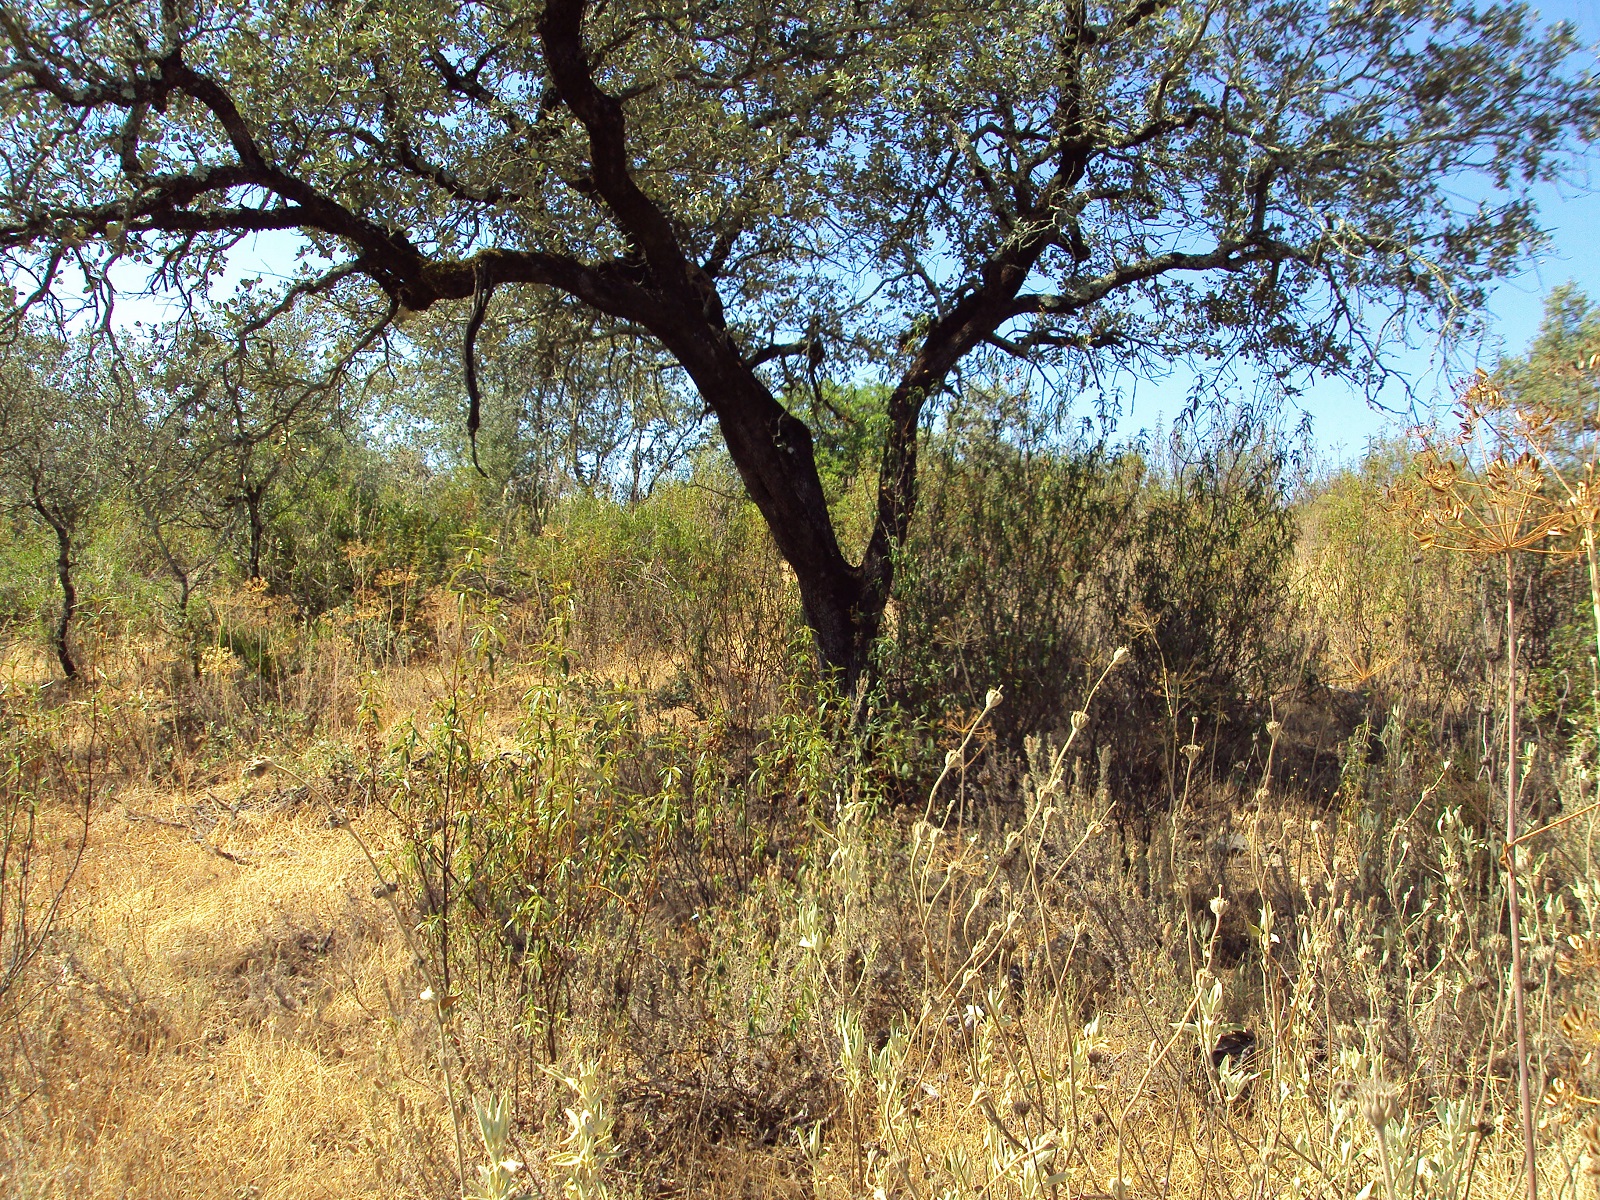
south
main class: Woodland
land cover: Broadleaved woodland
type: broadleaved evergreen forest
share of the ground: 25 - 50 %
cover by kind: shrubs 70 %, broadleaved forest trees 30 %
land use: Semi-natural and natural areas not in use
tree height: < 5 m
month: June
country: ES
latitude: 37.4217
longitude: -6.9113
